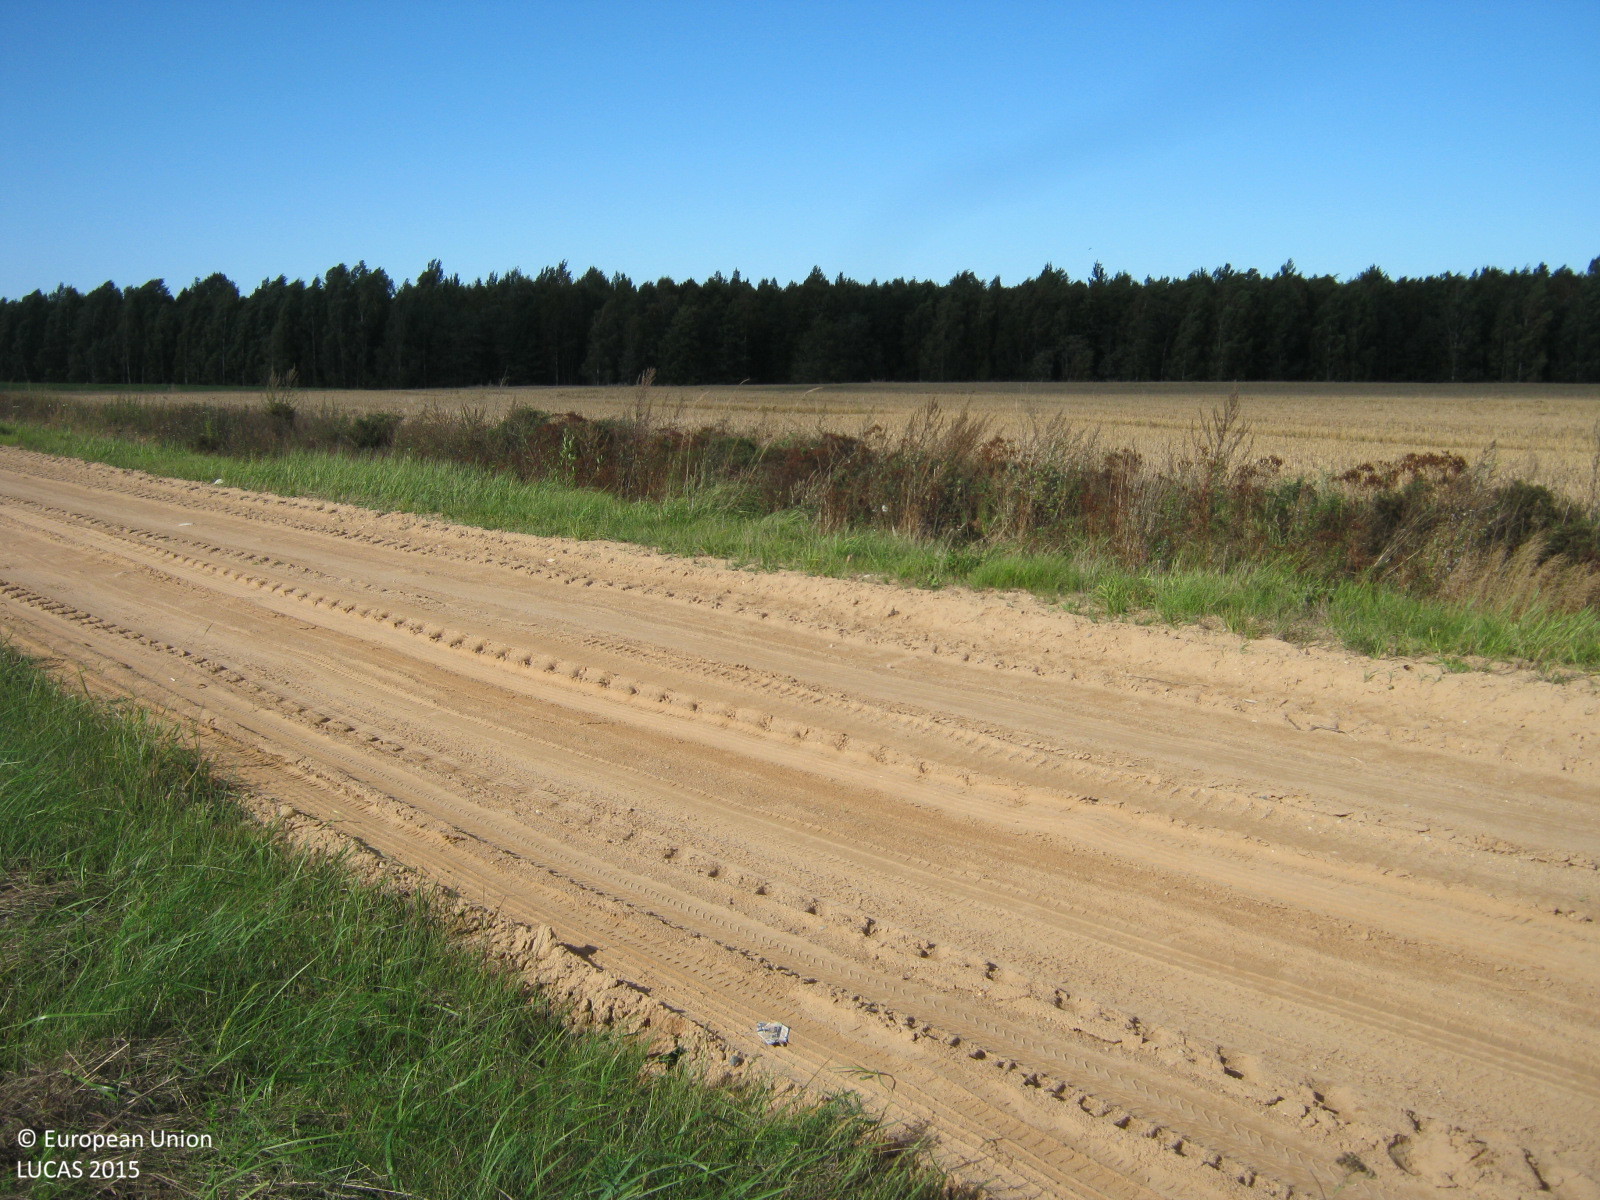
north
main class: Grassland
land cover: Grassland without tree/shrub cover
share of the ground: > 75 %
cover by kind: herbaceous plants 100 %
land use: Agriculture (excluding fallow land and kitchen gardens)
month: September
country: LV
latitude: 57.2338
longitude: 24.5904
